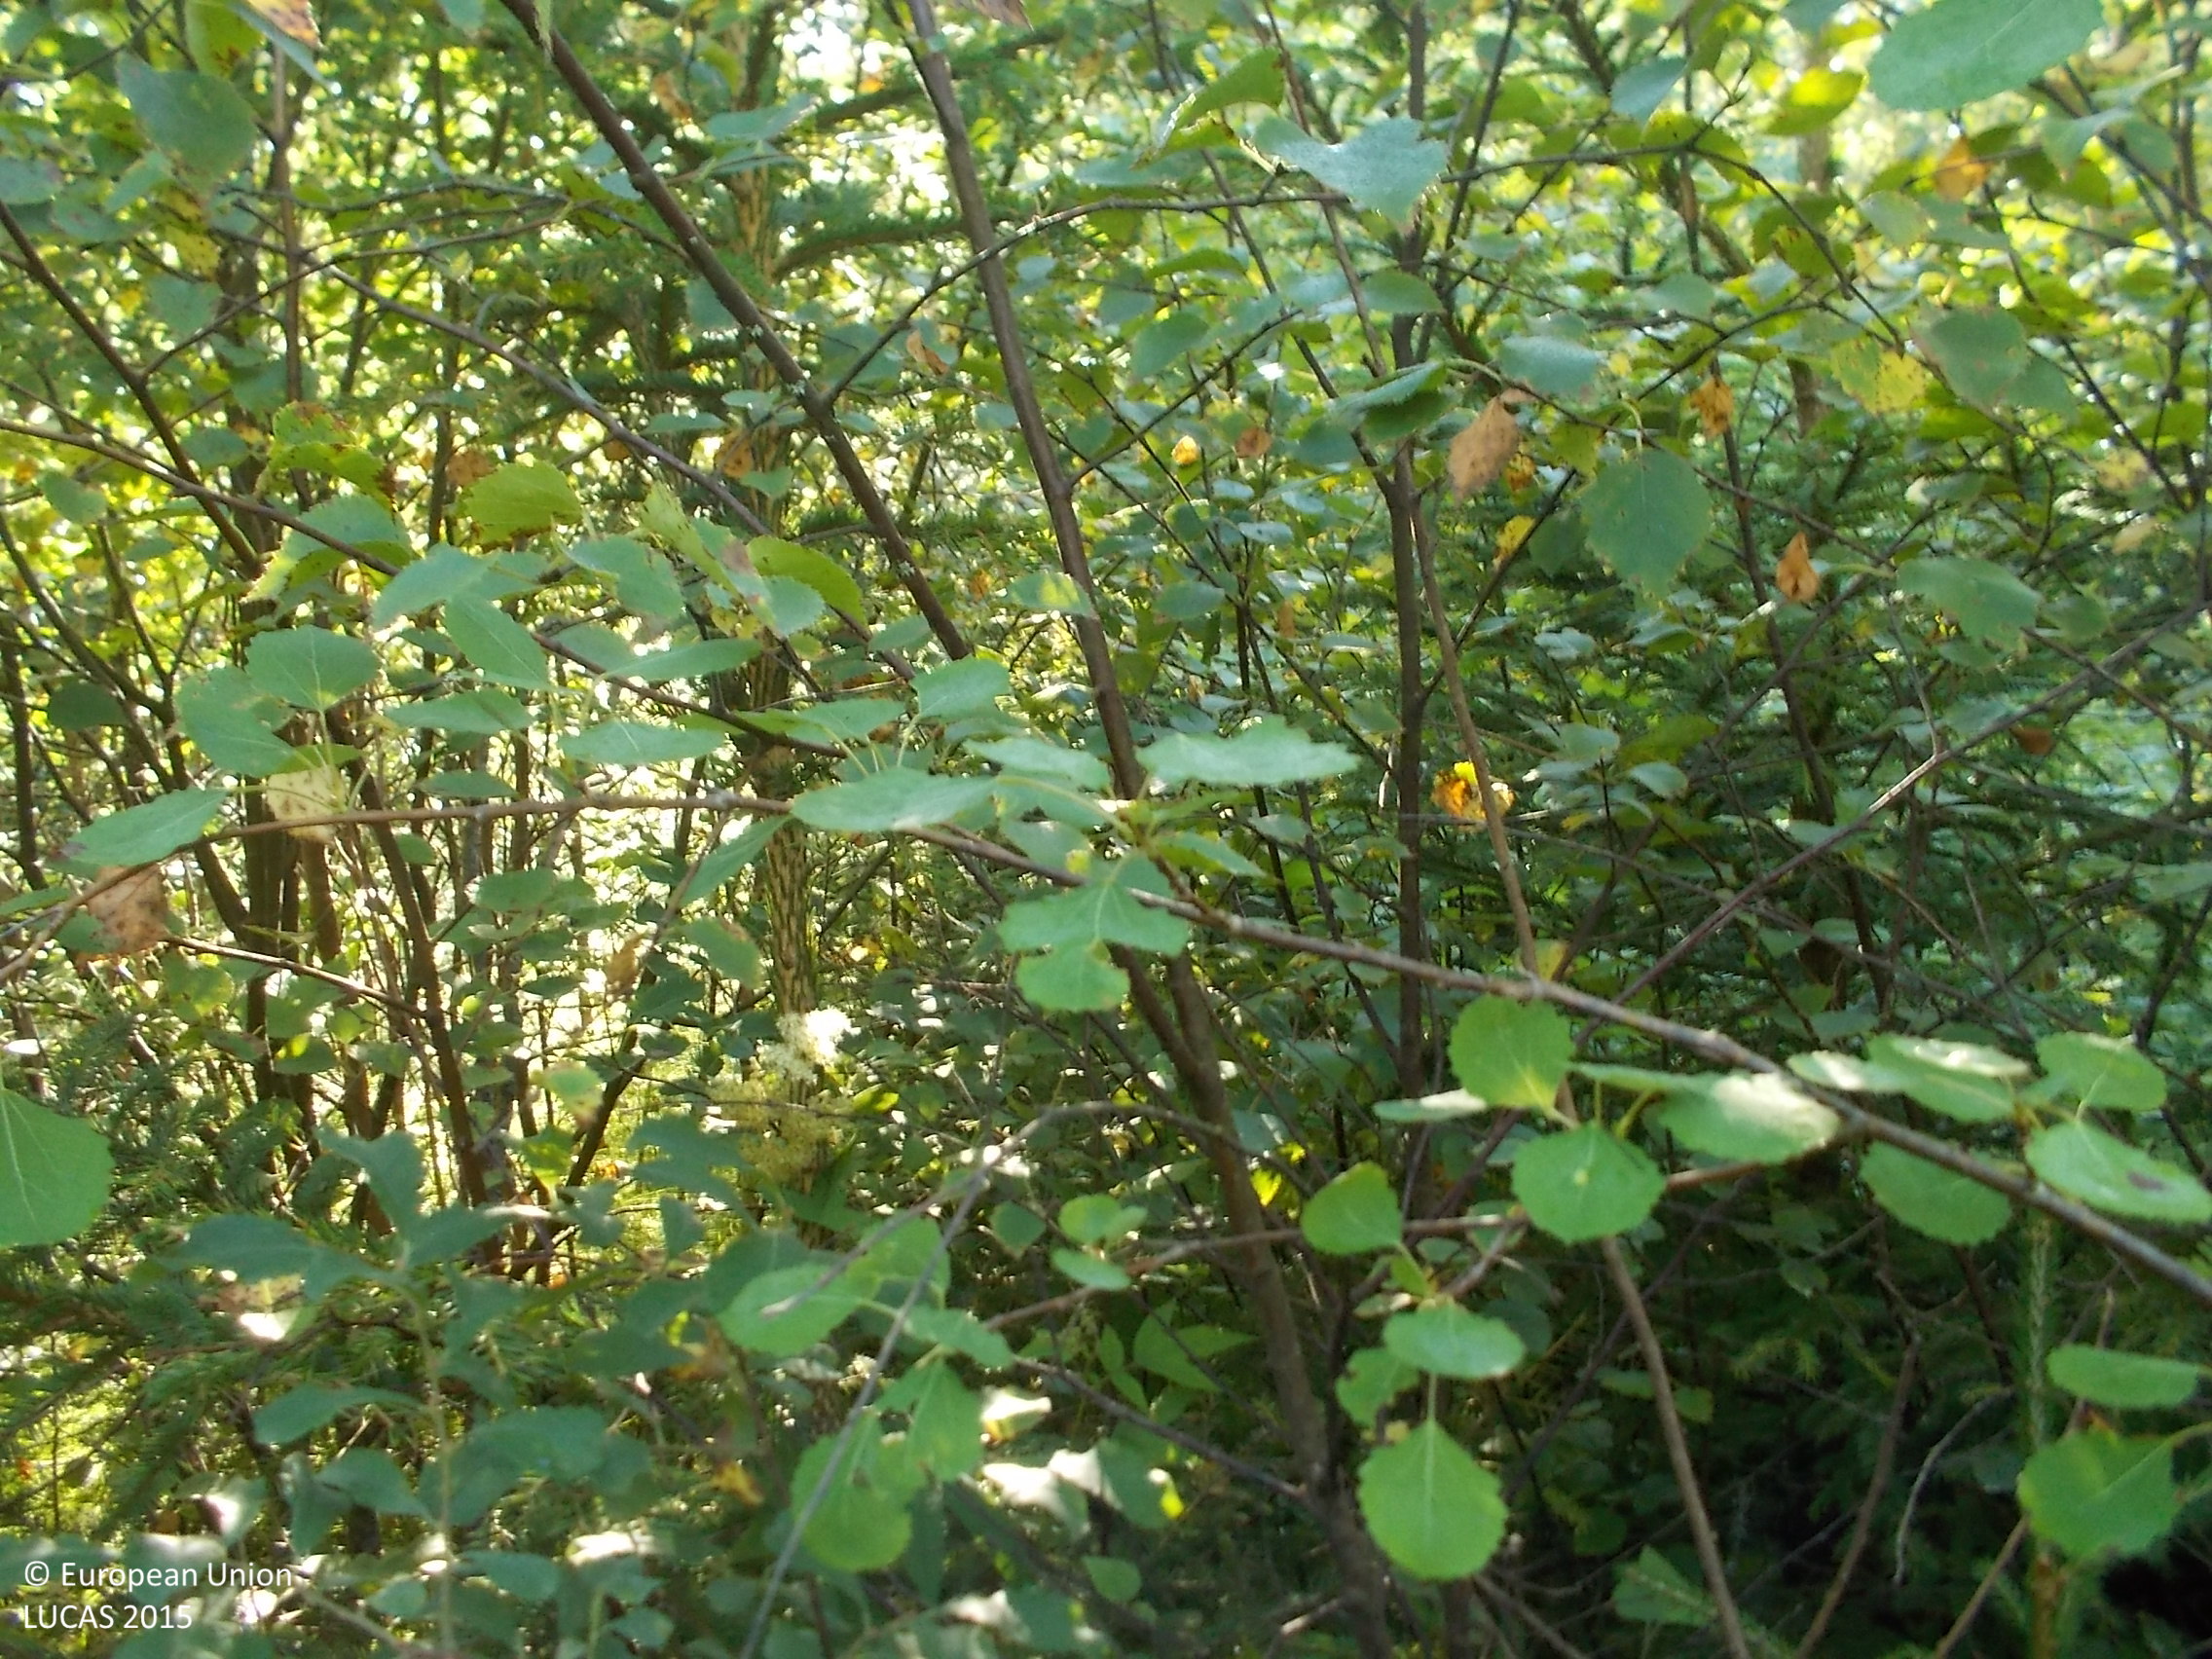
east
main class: Woodland
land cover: Spruce dominated mixed woodland
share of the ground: > 75 %
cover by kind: broadleaved forest trees 60 %, coniferous forest trees 30 %, herbaceous plants 10 %
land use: Forestry
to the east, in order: Spruce dominated mixed woodland; Broadleaved woodland; Dry stone walls; Spruce dominated coniferous woodland; Grass margins; Broadleaved woodland; Dry stone walls; Tracks; Dry stone walls; Pine dominated mixed woodland; Shrubland with sparse tree cover; Spruce dominated mixed woodland
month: August
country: SE
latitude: 57.5681
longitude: 13.2556
